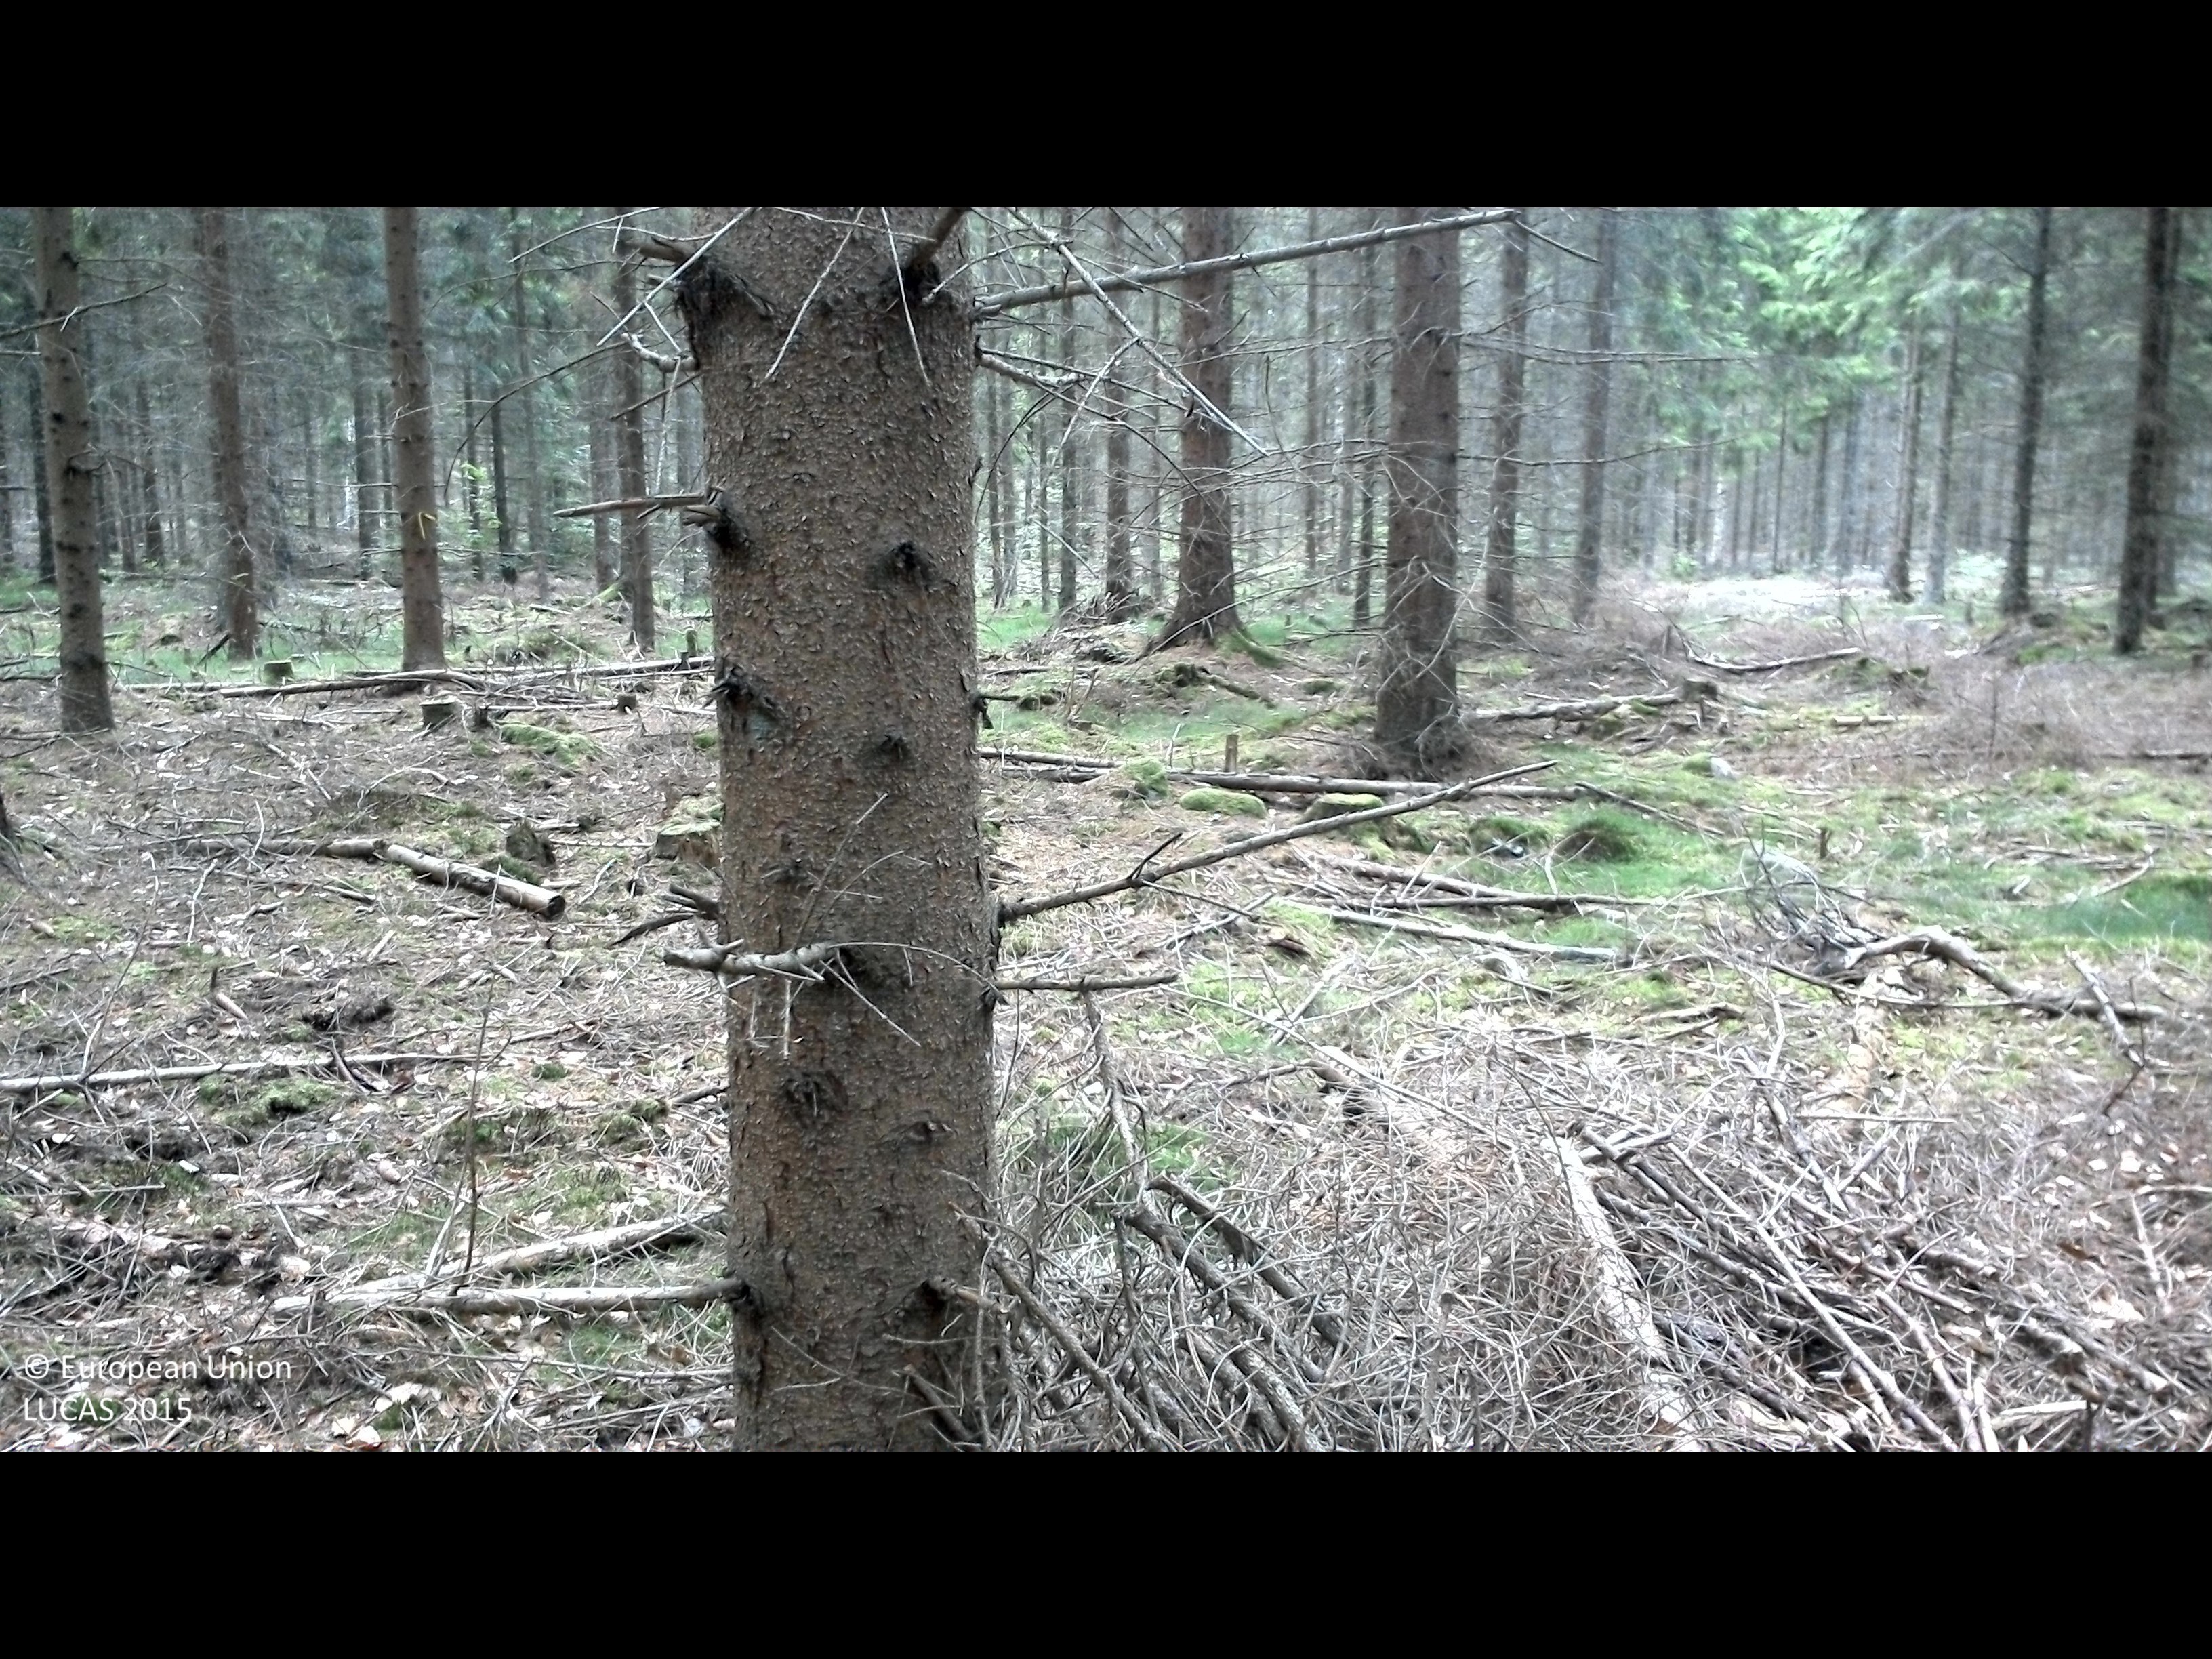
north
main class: Woodland
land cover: Spruce dominated coniferous woodland
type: boreal forest
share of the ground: > 75 %
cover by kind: coniferous forest trees 85 %, lichens and mosses 15 %
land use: Forestry
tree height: > 5 m
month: June
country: SE
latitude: 56.2673
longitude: 15.9263
